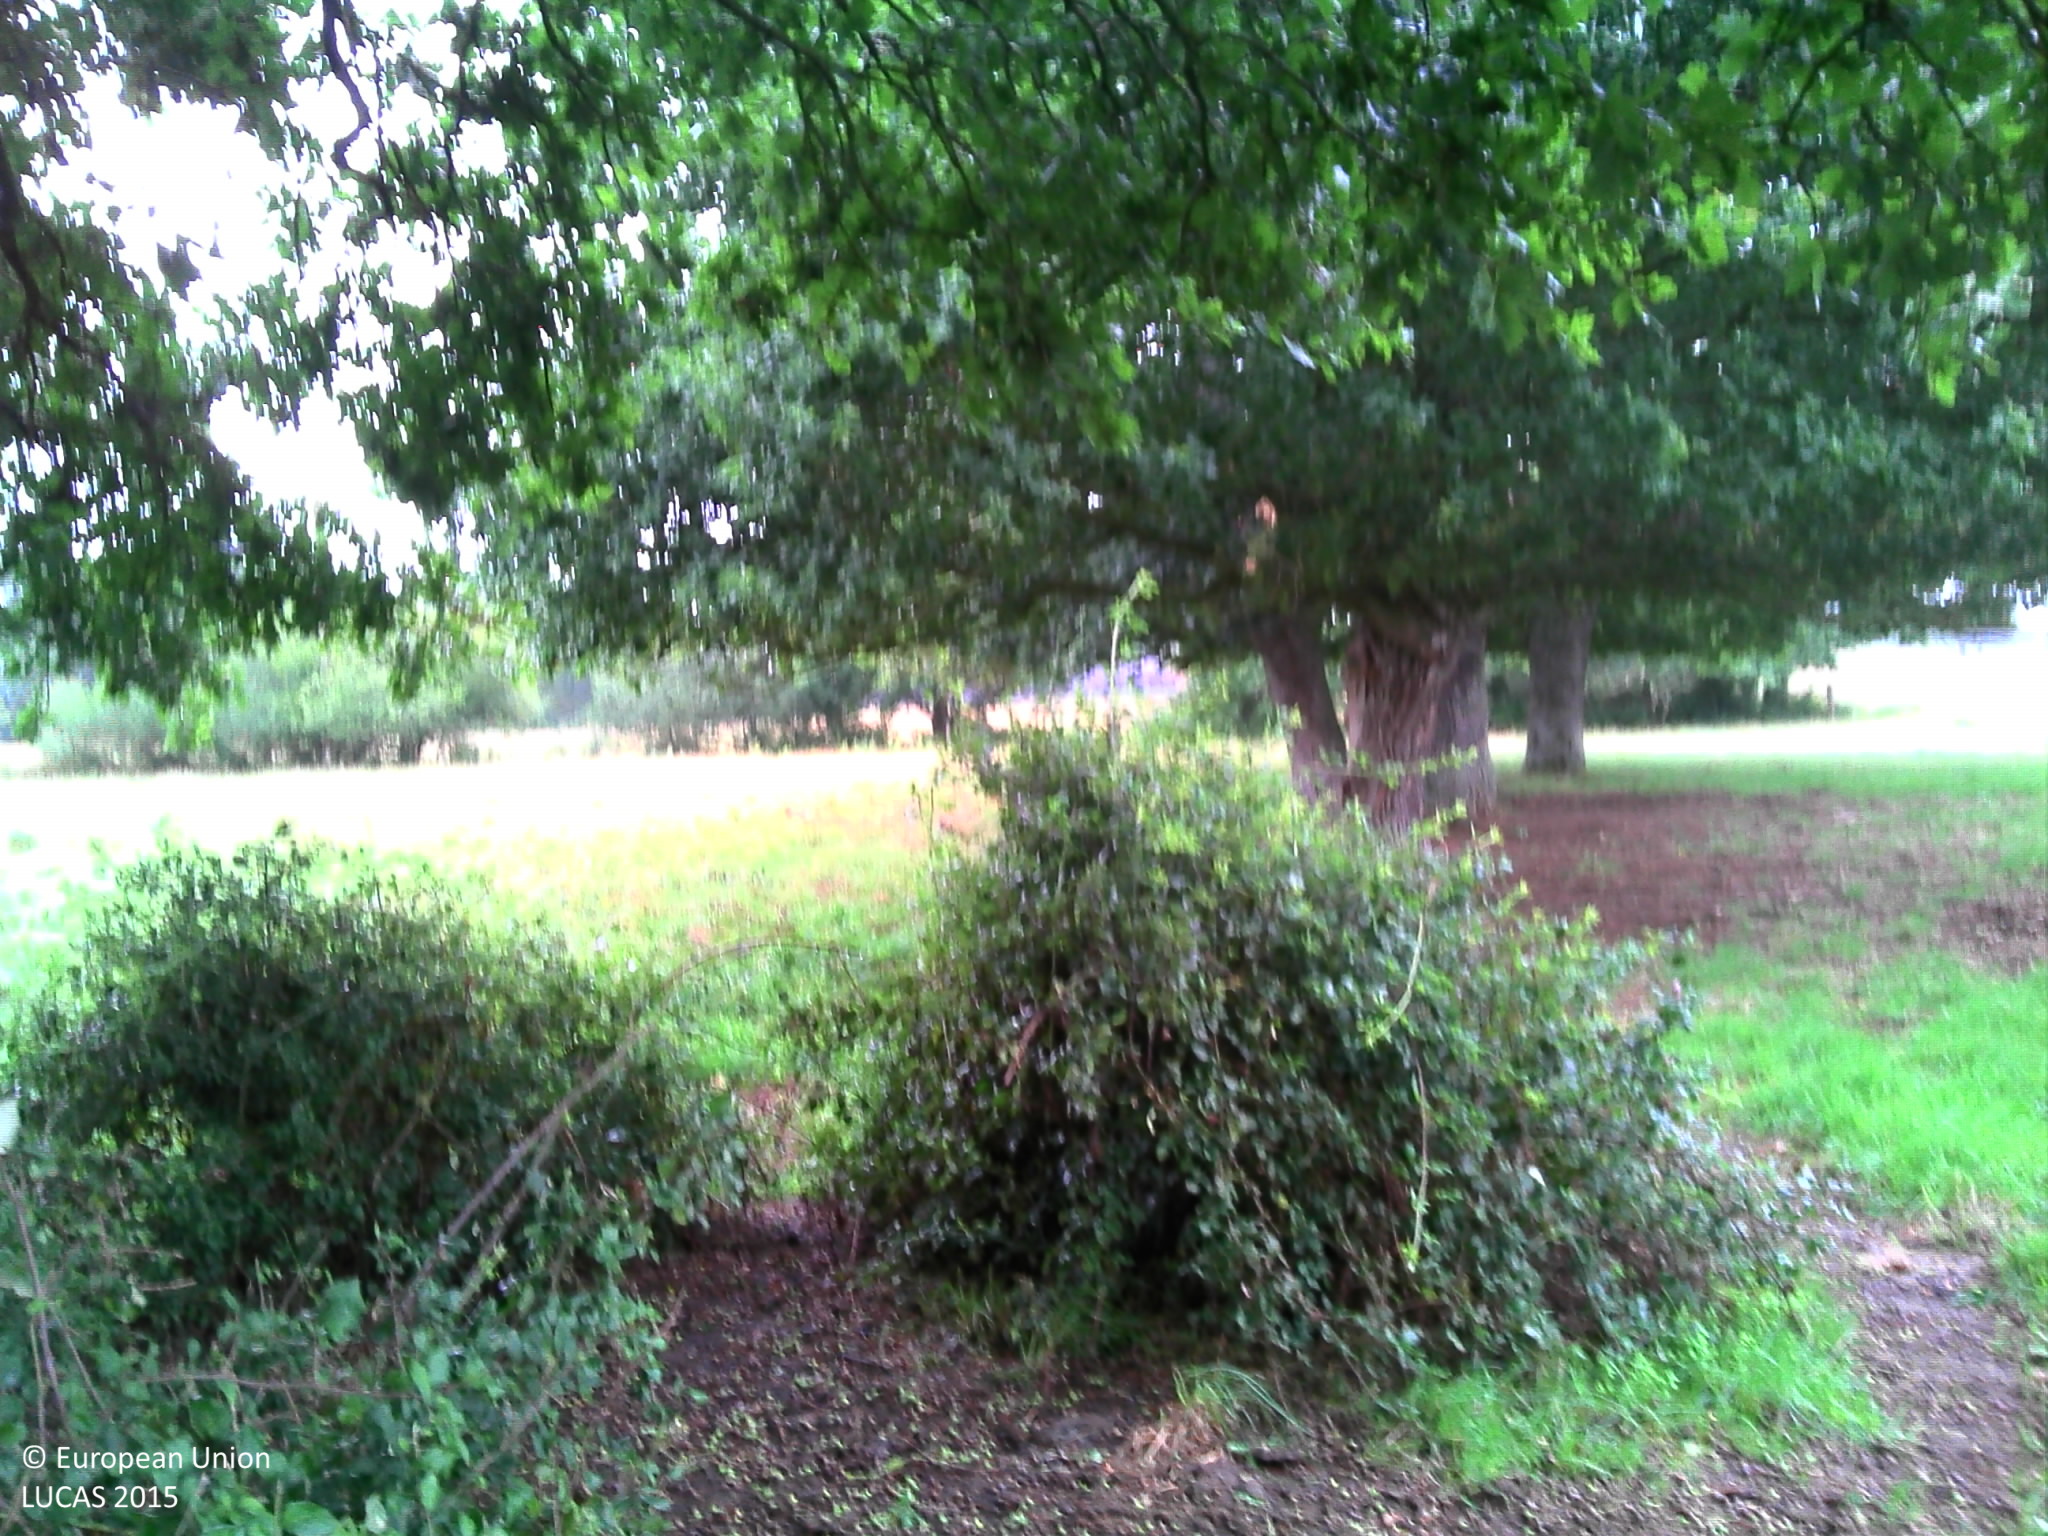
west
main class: Woodland
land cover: Broadleaved woodland
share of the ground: > 75 %
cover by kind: herbaceous plants 80 %, broadleaved forest trees 10 %, unconsolidated bare surface 10 %
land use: Semi-natural and natural areas not in use
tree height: > 5 m
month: August
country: FR
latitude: 48.3628
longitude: -2.0261
